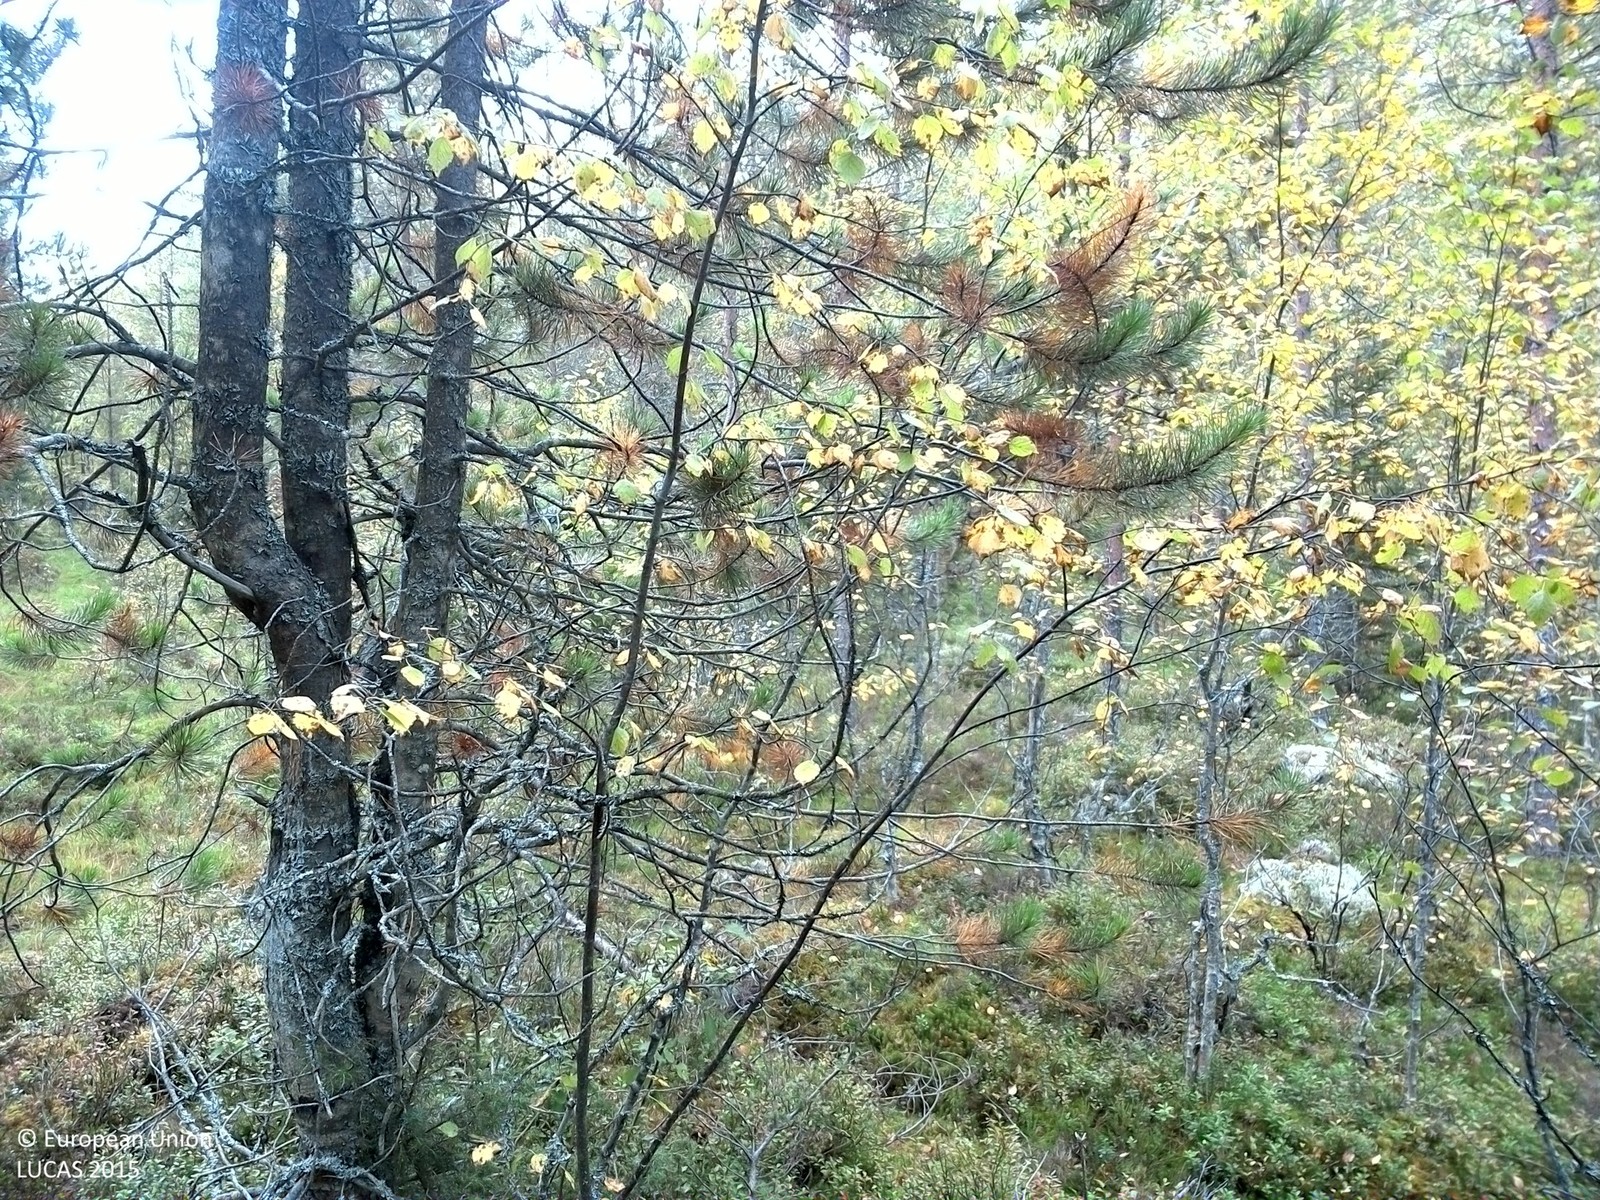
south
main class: Woodland
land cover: Pine dominated mixed woodland
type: exotic forest
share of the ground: 50 - 75 %
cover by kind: coniferous forest trees 50 %, broadleaved forest trees 20 %, shrubs 20 %, lichens and mosses 10 %
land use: Forestry
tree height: > 5 m
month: September
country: SE
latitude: 61.3609
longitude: 15.3524
